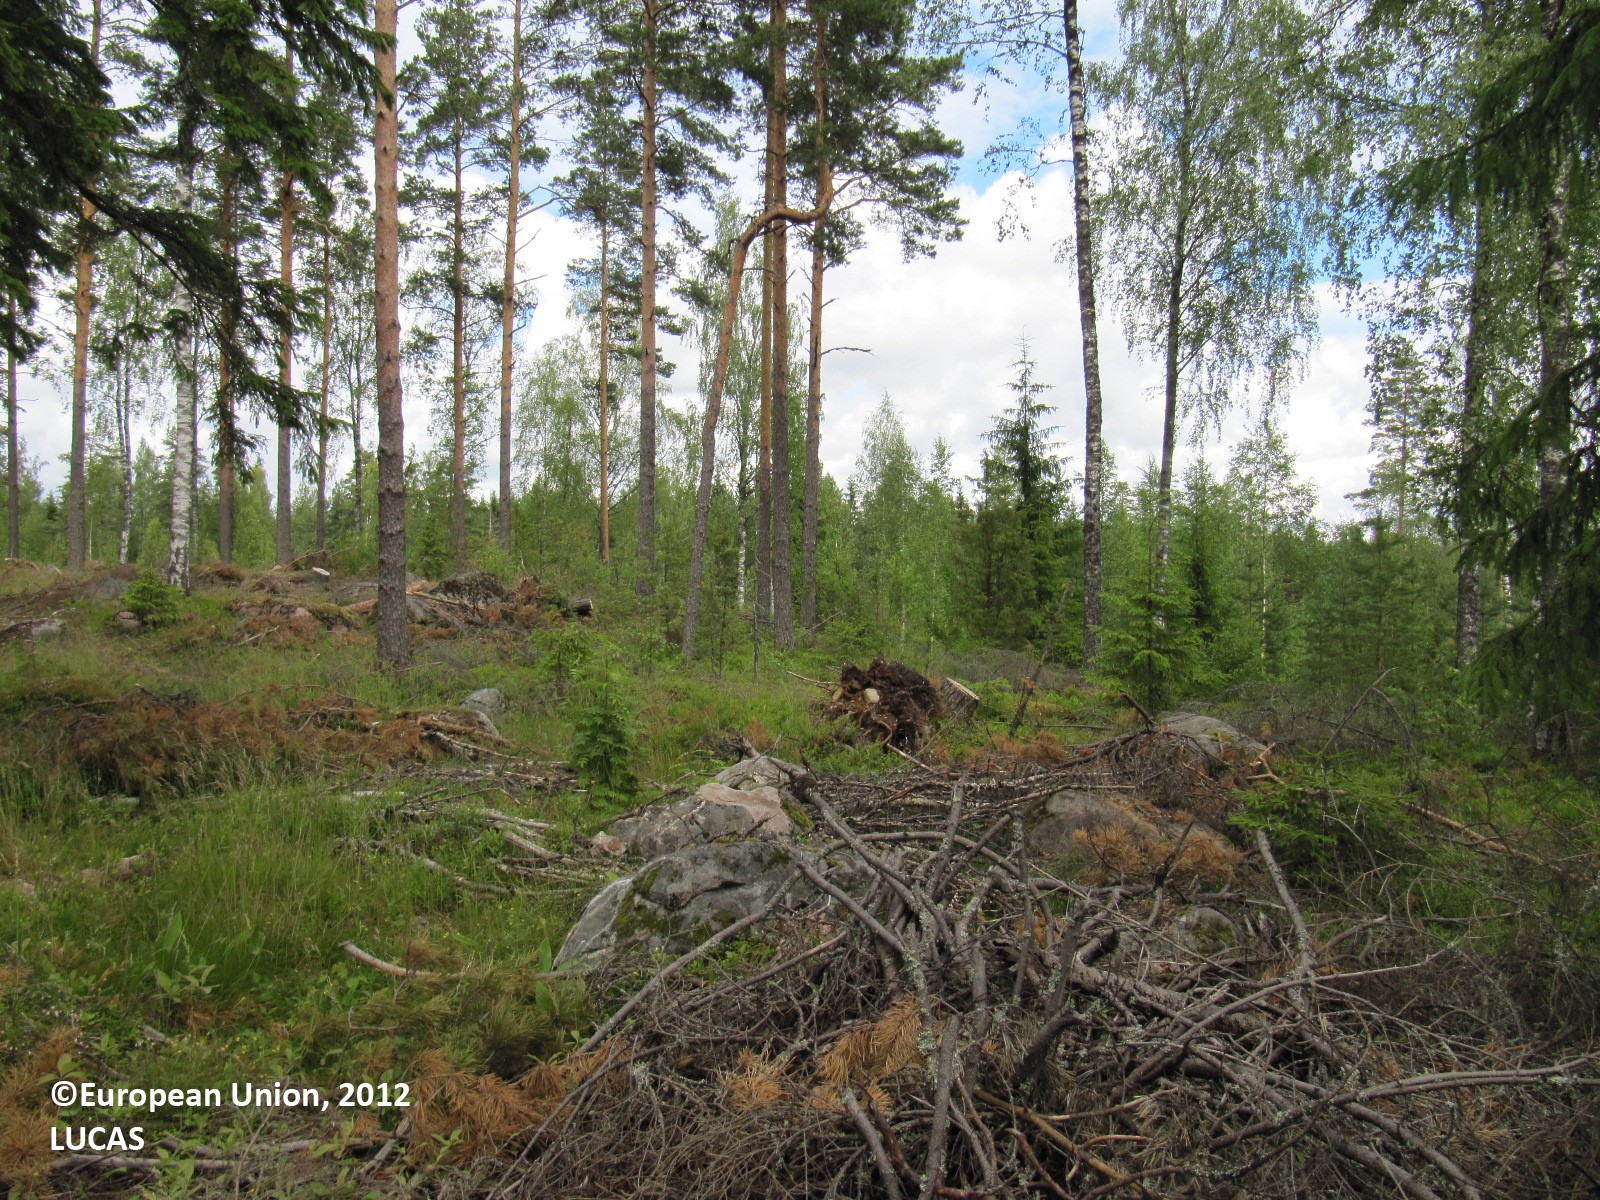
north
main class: Woodland
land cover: Pine dominated coniferous woodland
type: boreal forest
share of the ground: 50 - 75 %
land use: Forestry
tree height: > 5 m
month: June
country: FI
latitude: 60.5329
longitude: 24.2612
